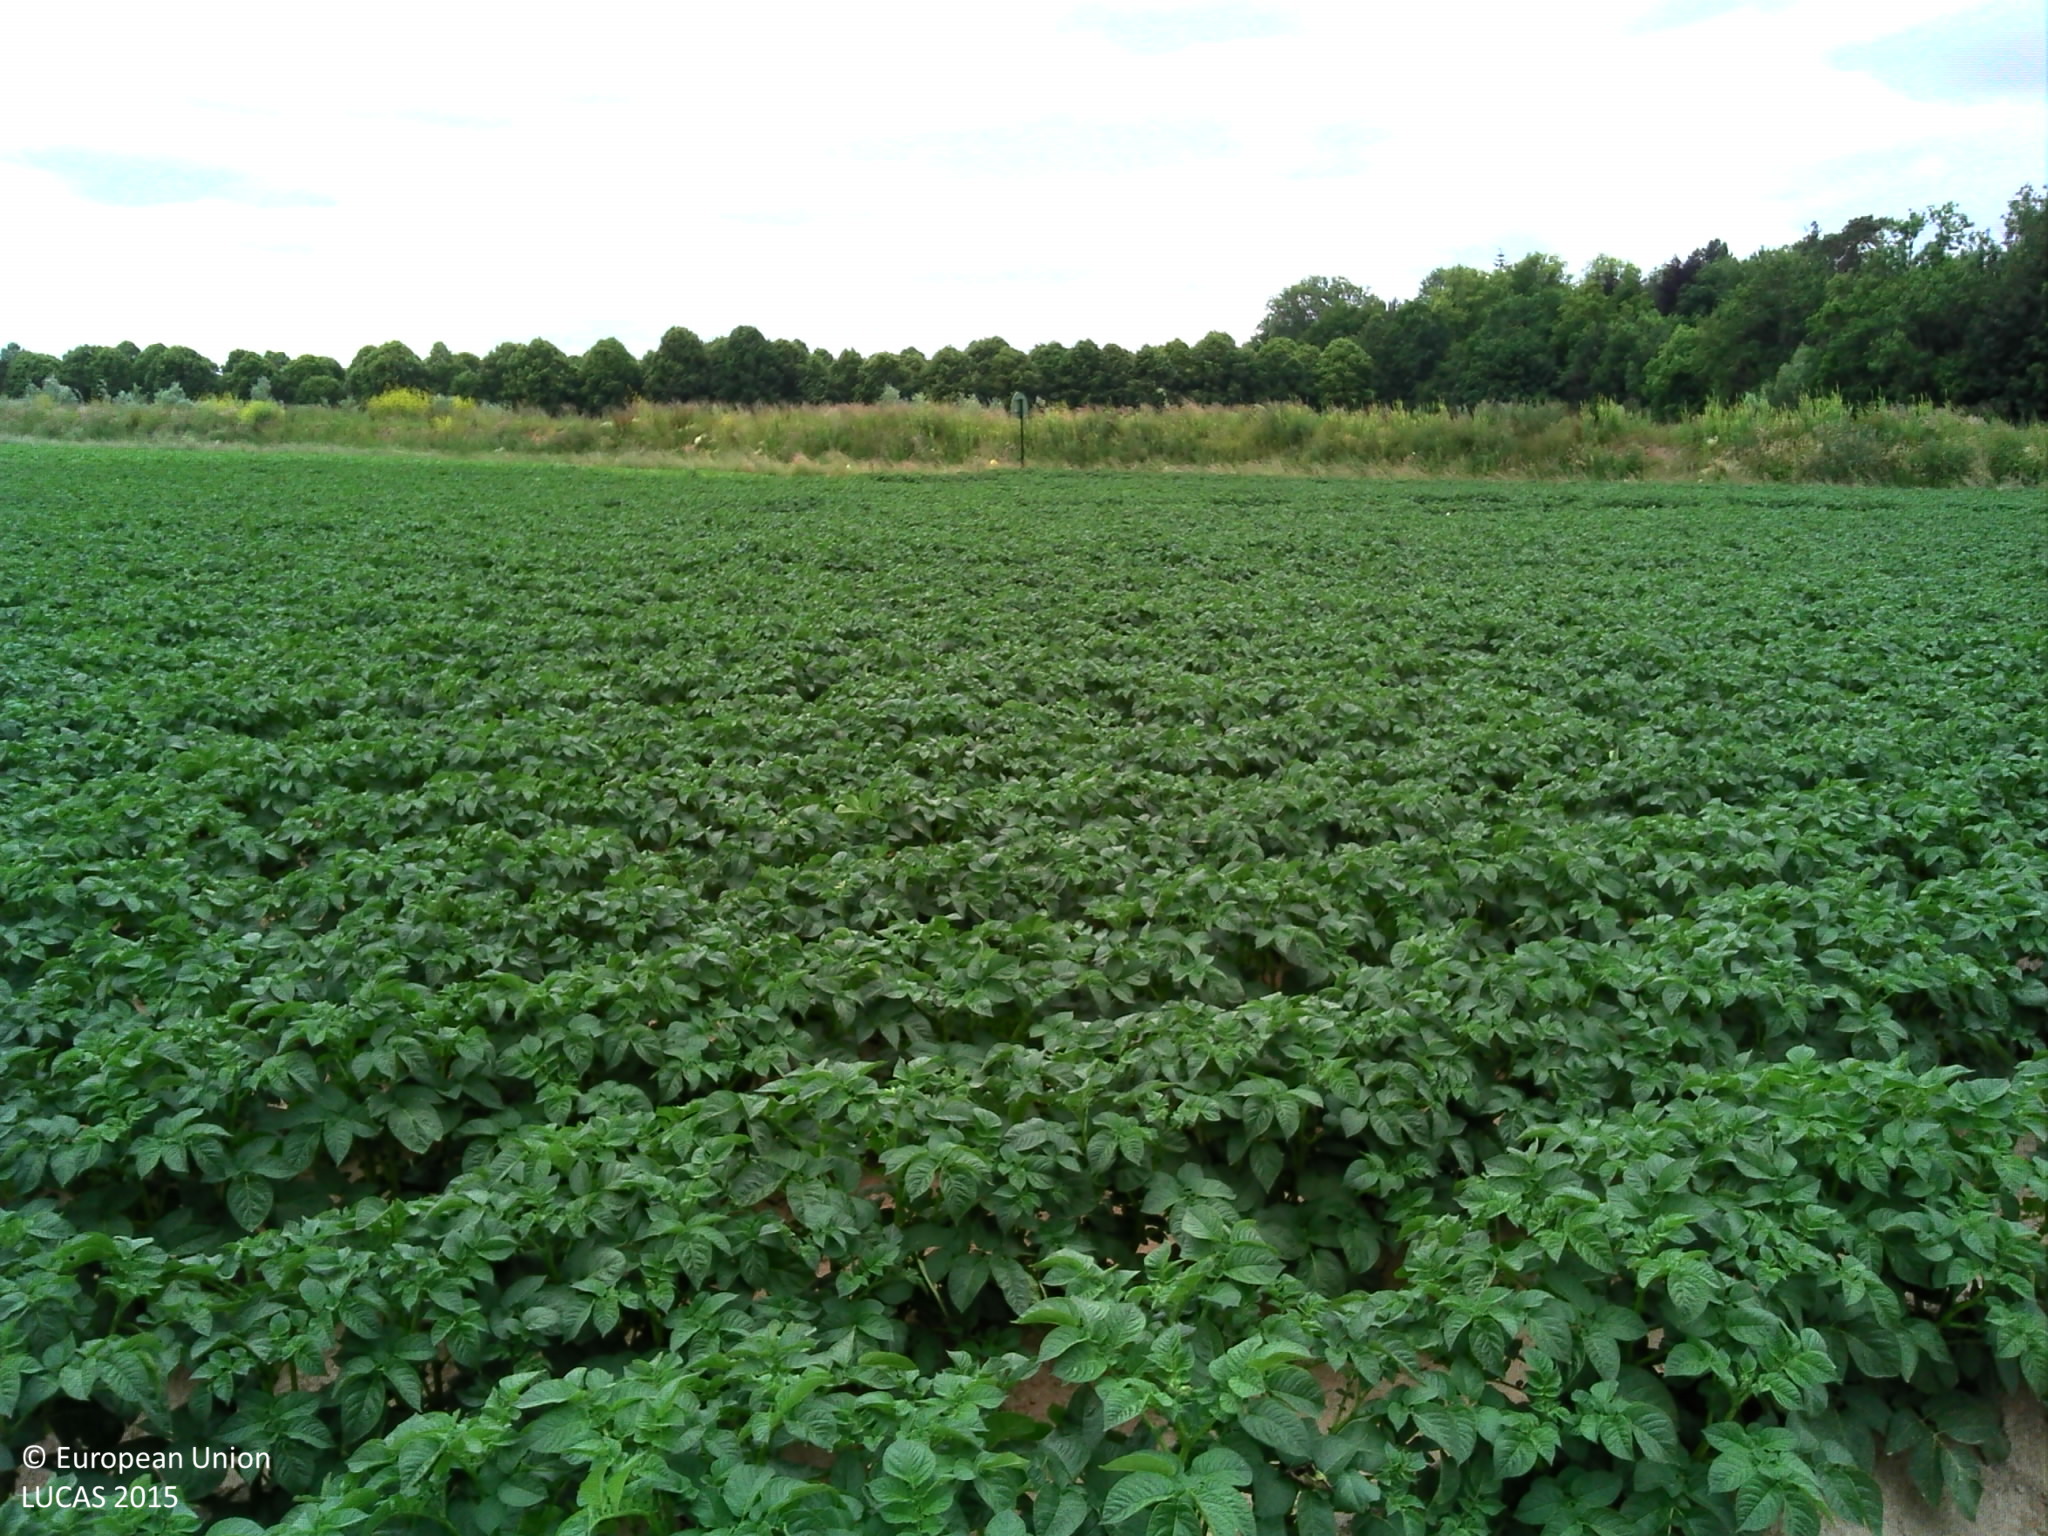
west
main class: Cropland
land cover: Potatoes
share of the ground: > 75 %
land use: Agriculture (excluding fallow land and kitchen gardens)
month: June
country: FR
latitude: 50.6843
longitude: 2.3292
